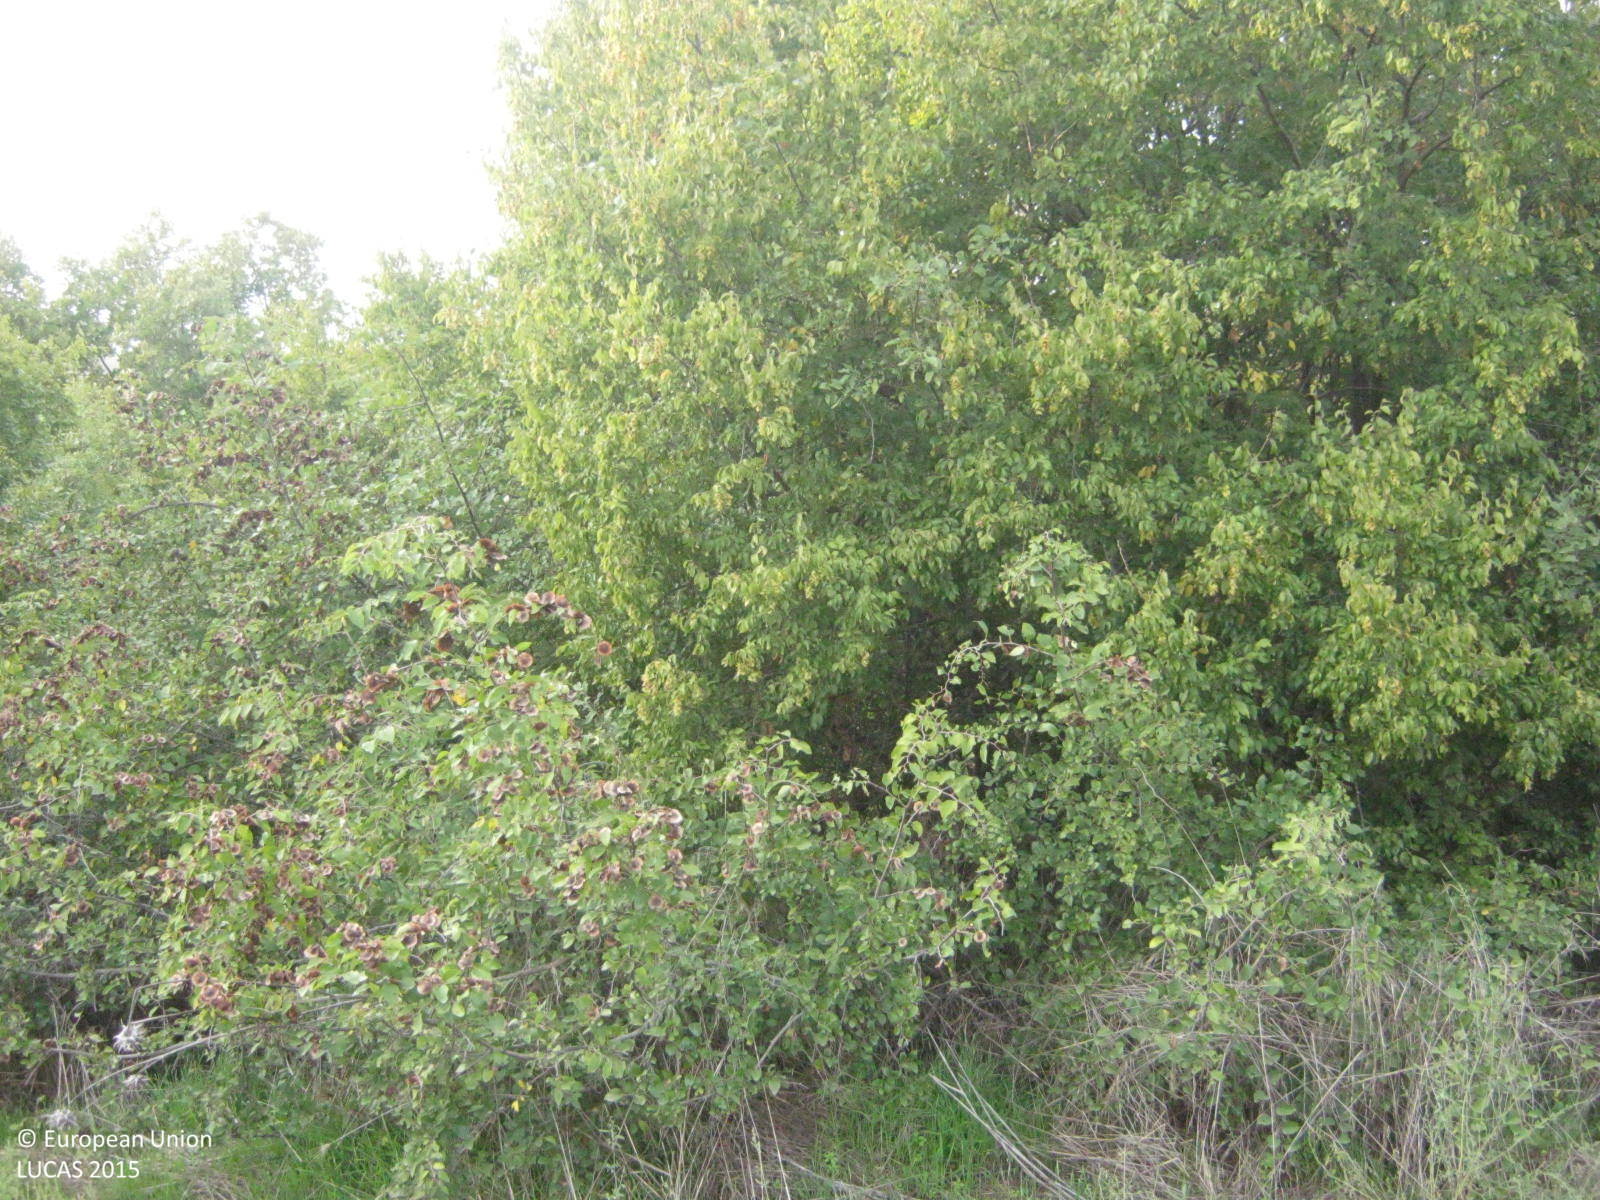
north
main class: Woodland
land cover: Broadleaved woodland
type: thermophilous deciduous forest
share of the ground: > 75 %
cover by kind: broadleaved forest trees 75 %, shrubs 15 %, herbaceous plants 10 %
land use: Semi-natural and natural areas not in use
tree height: > 5 m
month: October
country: GR
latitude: 40.9746
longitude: 22.9768
